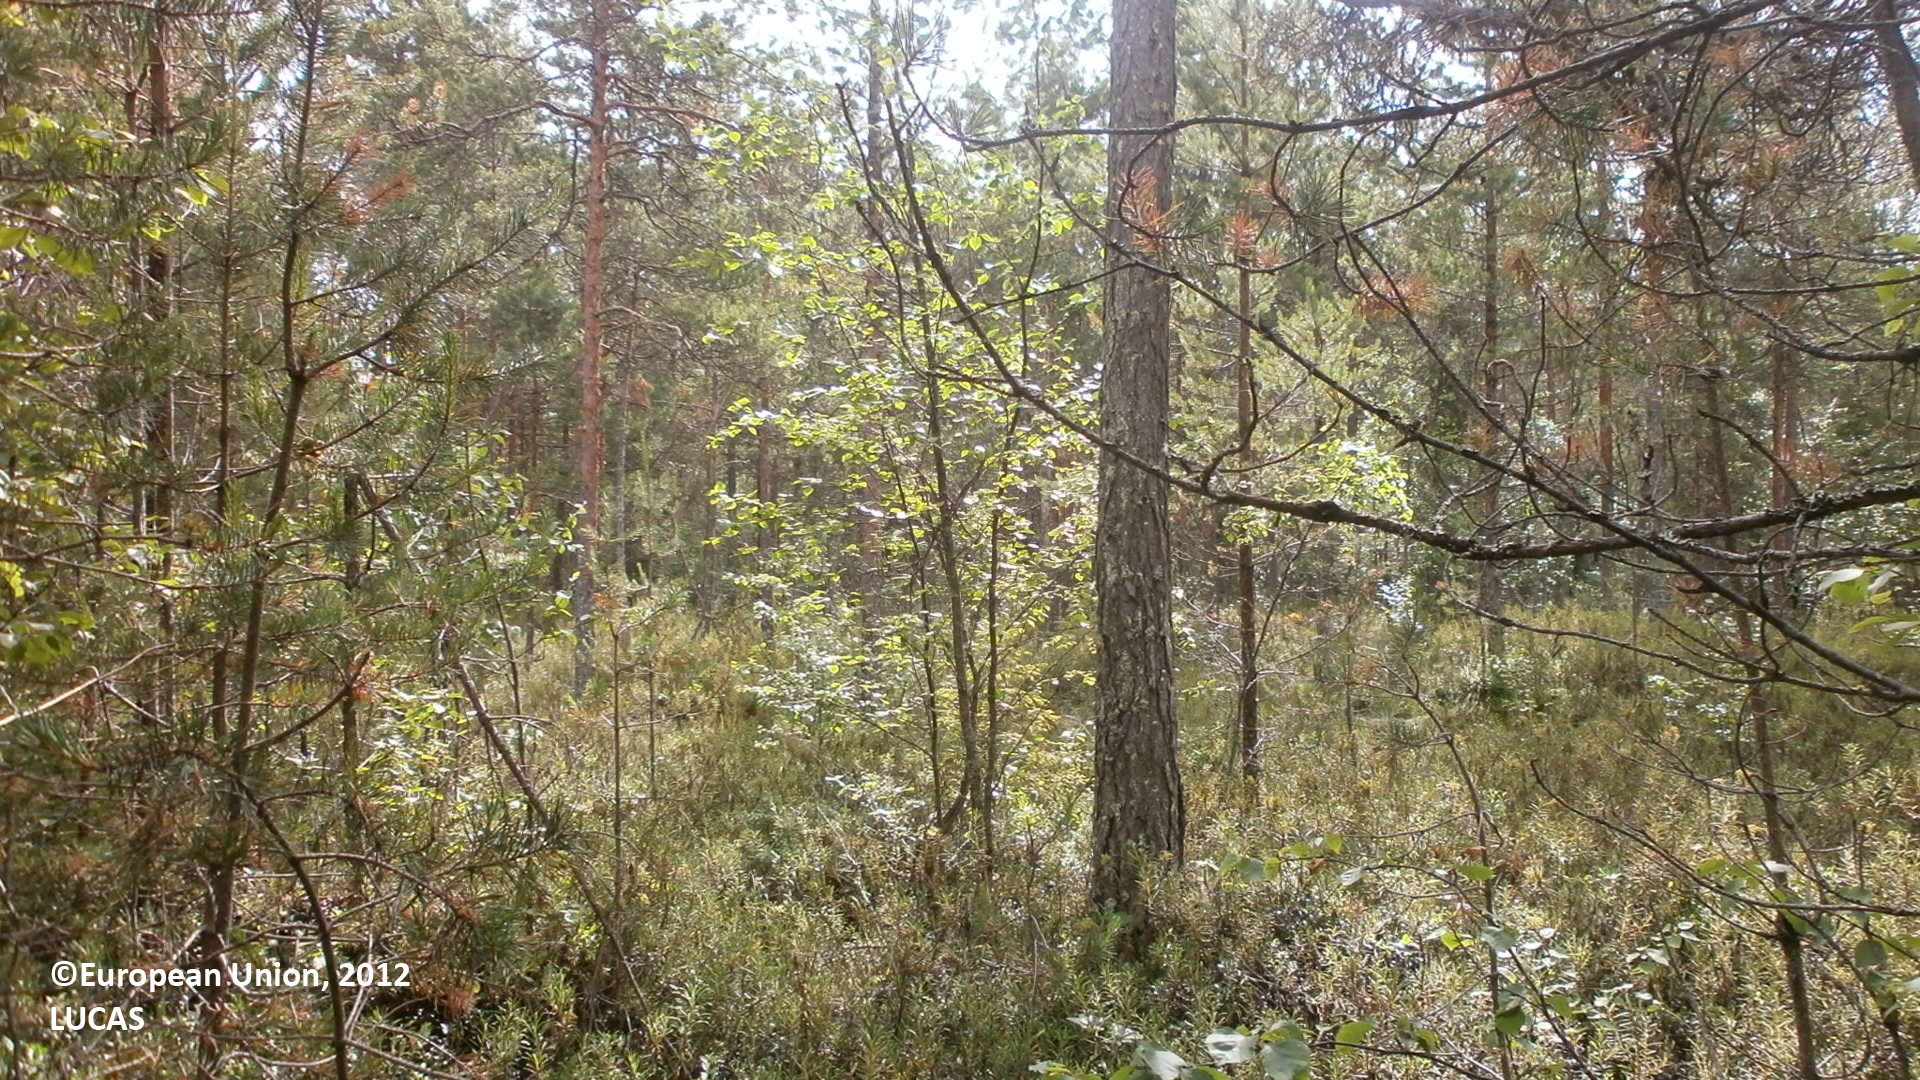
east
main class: Woodland
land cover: Pine dominated coniferous woodland
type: boreal forest
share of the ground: 50 - 75 %
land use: Forestry
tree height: > 5 m
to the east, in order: Pine dominated coniferous woodland; Ditches and canals; Pine dominated coniferous woodland; Ditches and canals; Pine dominated coniferous woodland; Ditches and canals; Pine dominated coniferous woodland; Ditches and canals; Pine dominated coniferous woodland; Ditches and canals; Pine dominated mixed woodland; Spontaneously vegetated surfaces; Pine dominated coniferous woodland; Spruce dominated coniferous woodland
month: July
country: FI
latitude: 64.5657
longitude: 24.4033
